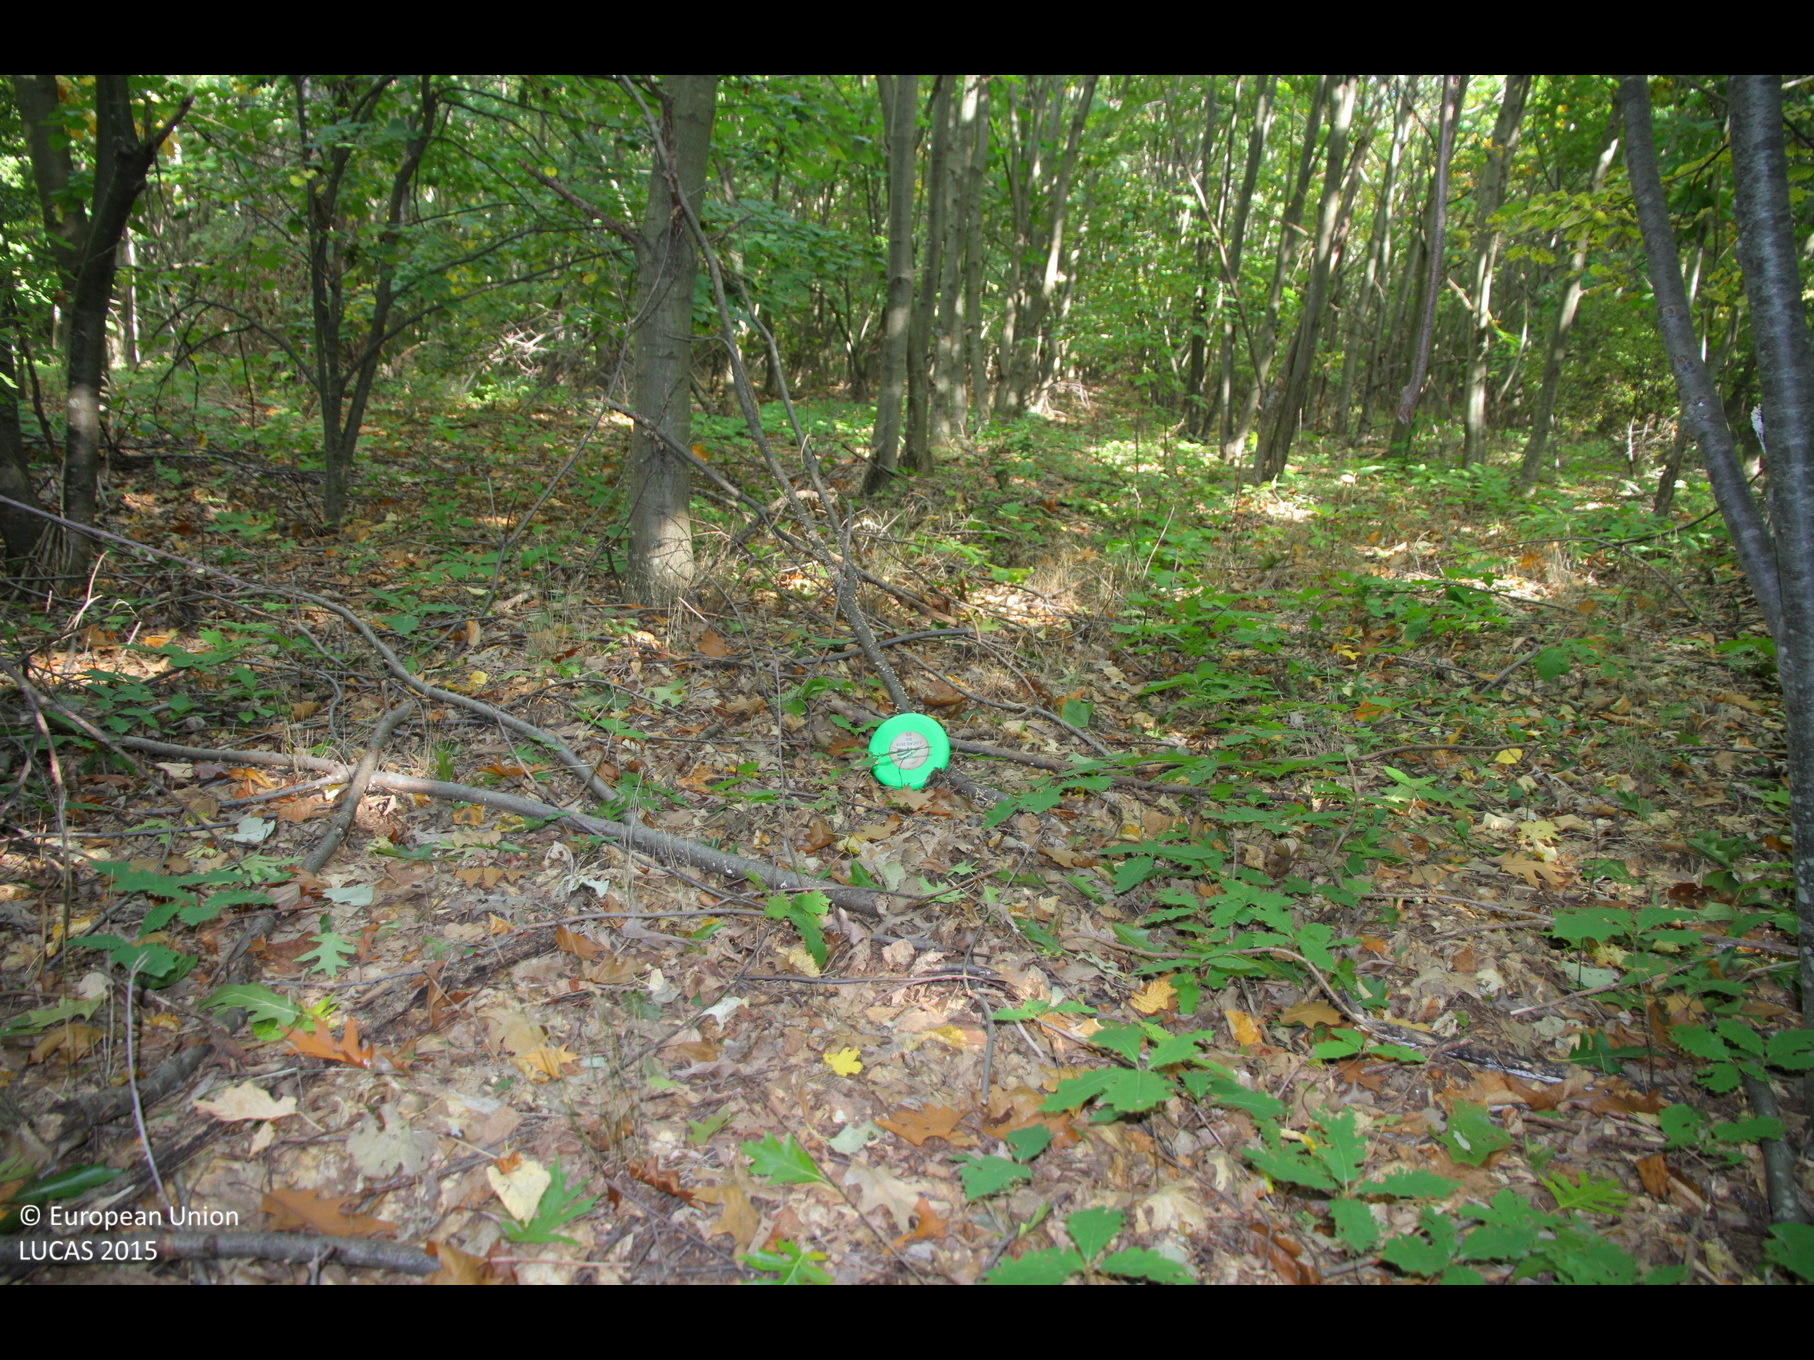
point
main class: Woodland
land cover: Broadleaved woodland
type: acidophilous oak and oak-birch forest
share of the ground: > 75 %
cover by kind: broadleaved forest trees 100 %
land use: Forestry
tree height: > 5 m
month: October
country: BG
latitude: 43.4863
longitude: 27.2236
